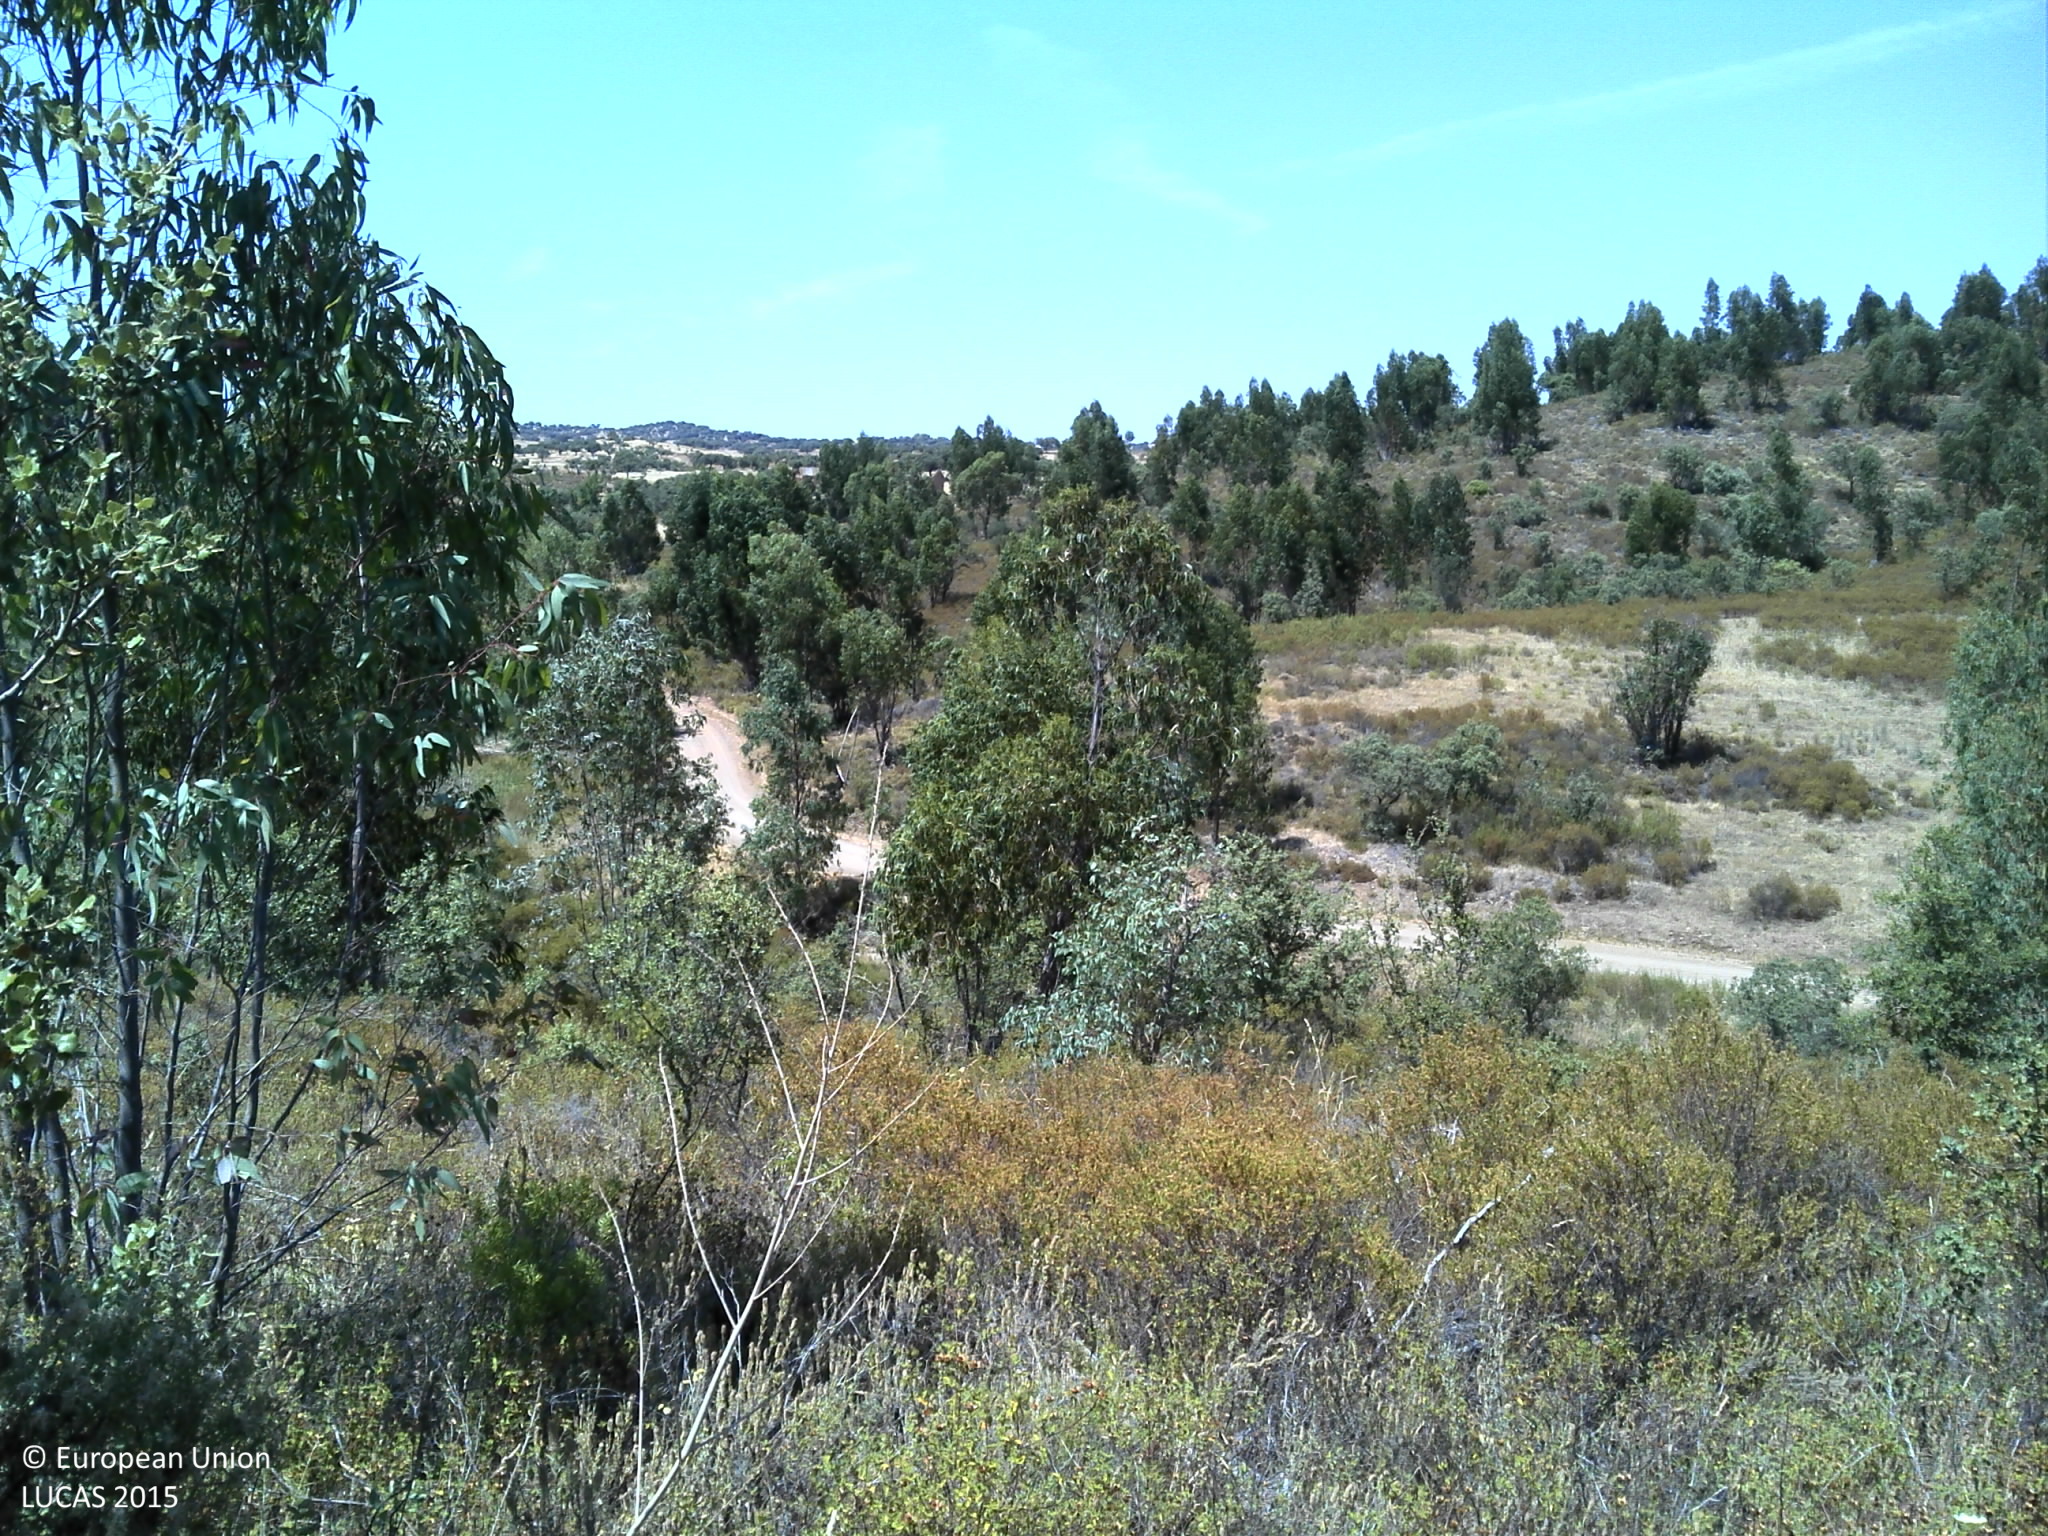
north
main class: Shrubland
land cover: Shrubland with sparse tree cover
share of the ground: > 75 %
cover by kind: shrubs 95 %, broadleaved forest trees 5 %
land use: Abandoned areas
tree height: < 5 m
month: June
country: PT
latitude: 37.6813
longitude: -7.5092
